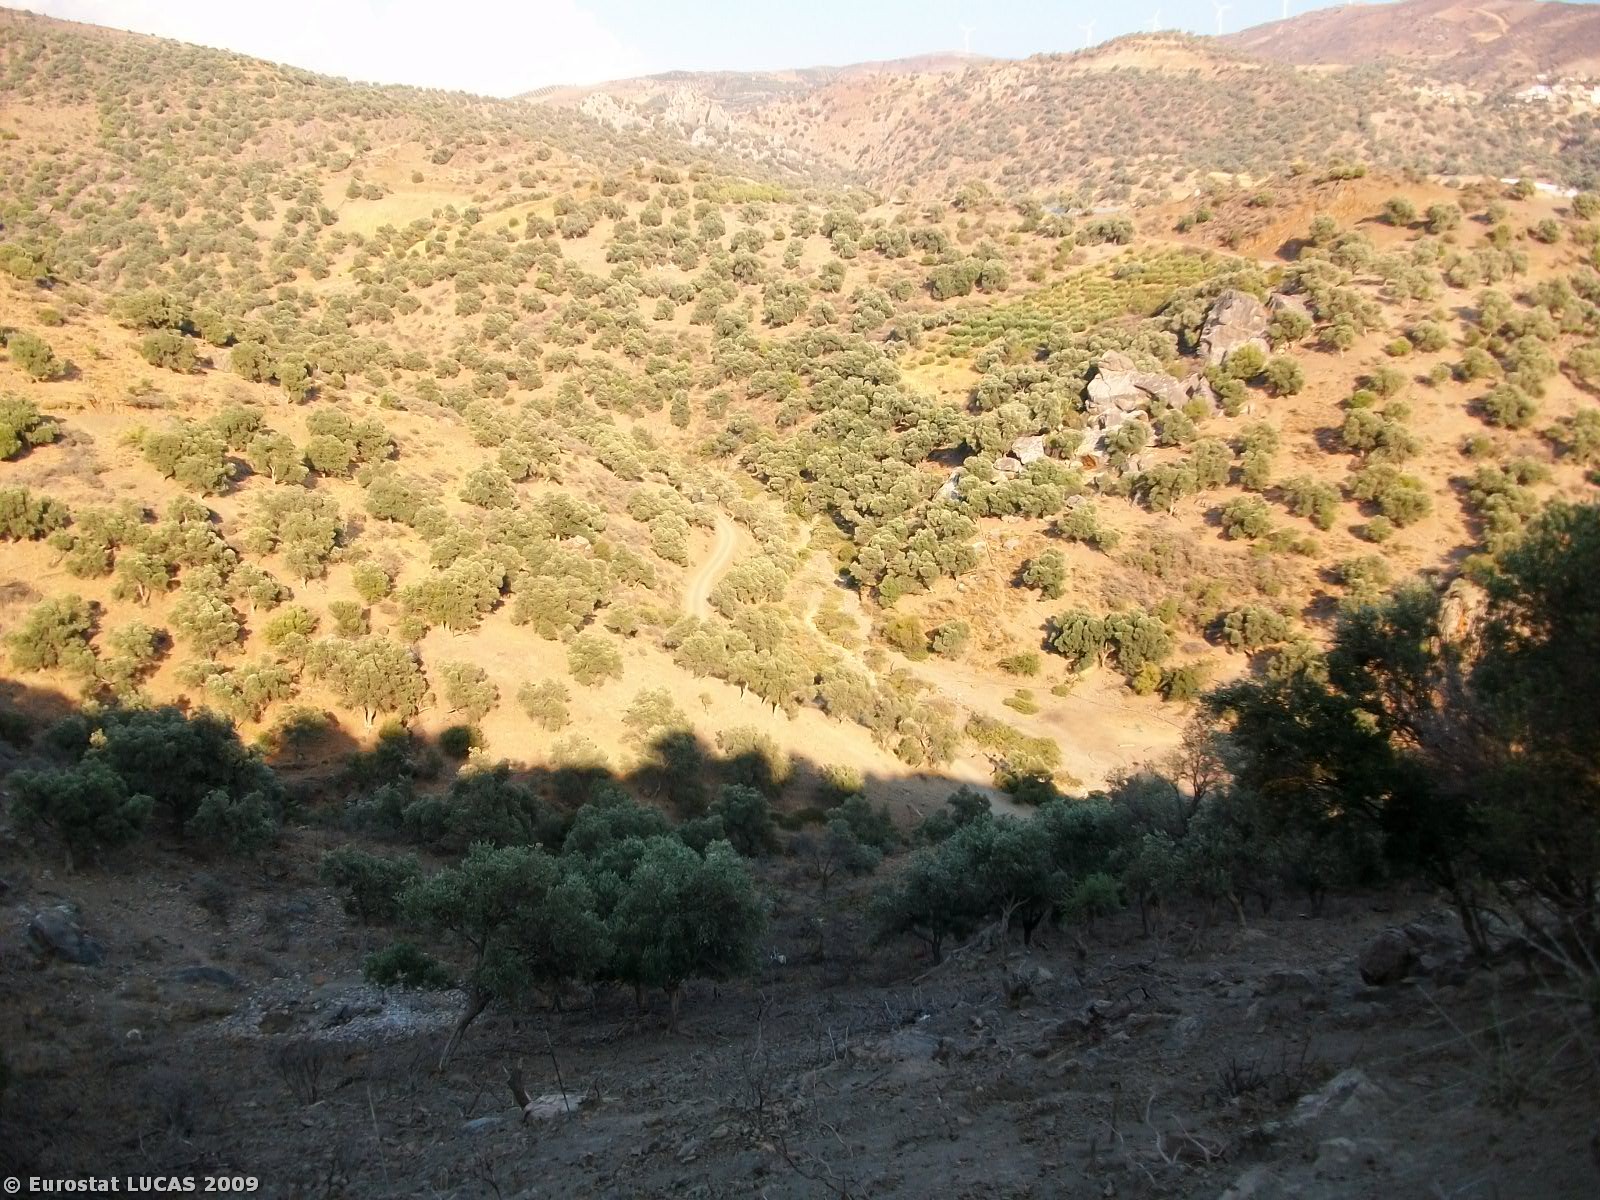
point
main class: Shrubland
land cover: Shrubland with sparse tree cover
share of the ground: 50 - 75 %
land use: Agriculture (excluding fallow land and kitchen gardens)
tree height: < 5 m
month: June
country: GR
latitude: 34.9689
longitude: 24.8676
